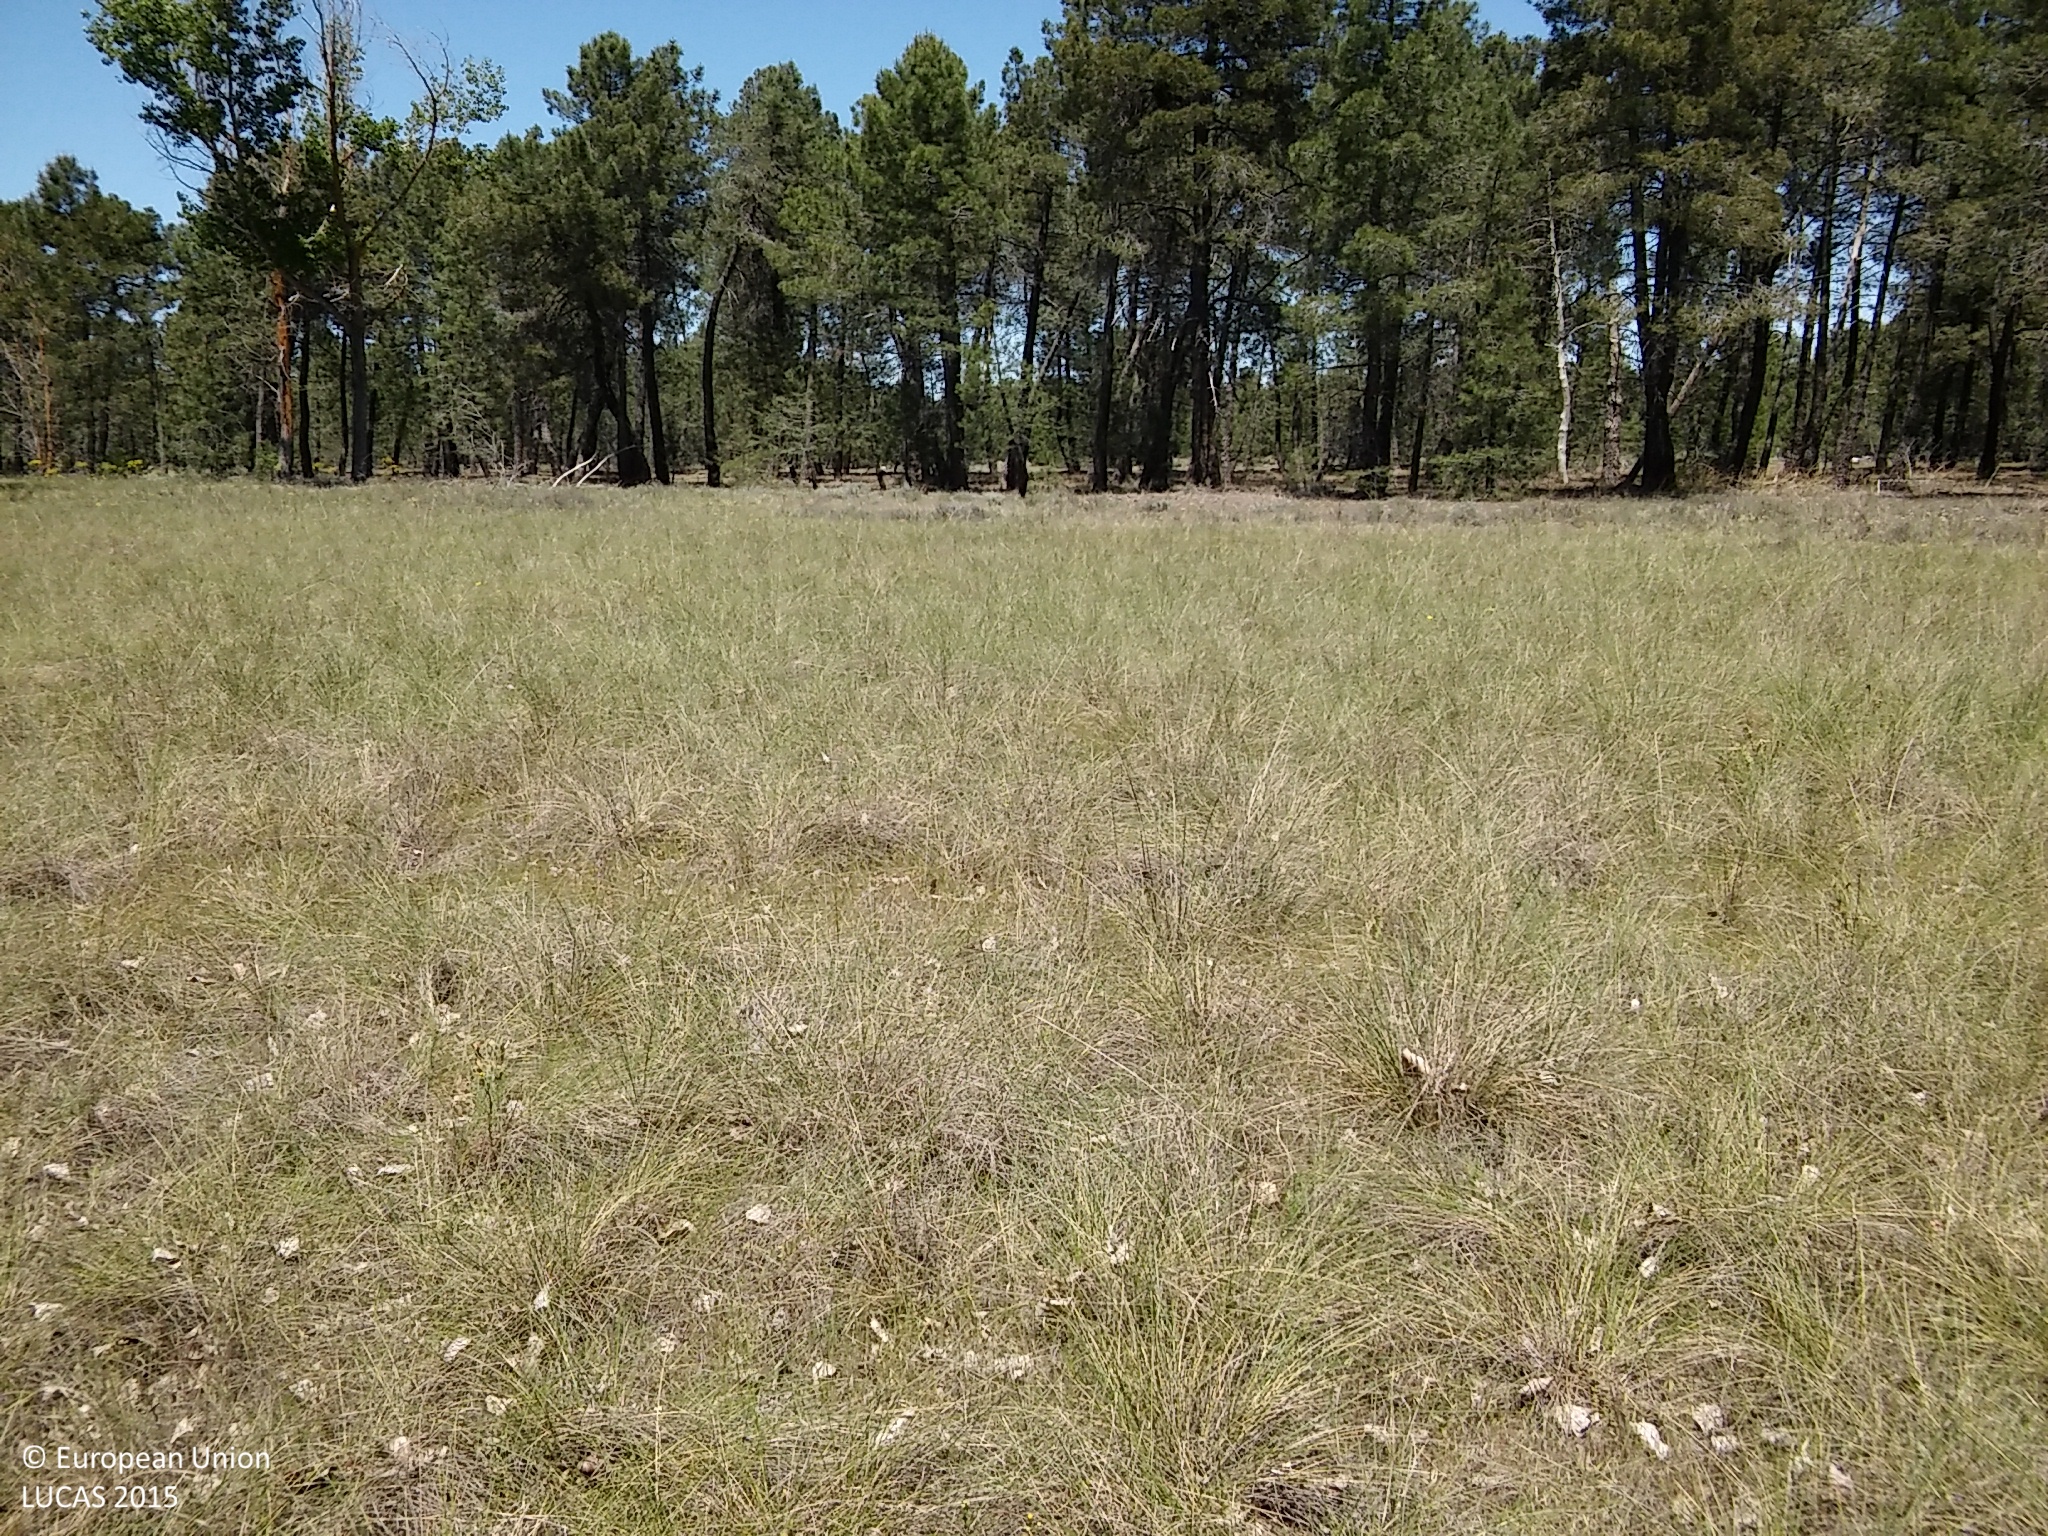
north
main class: Grassland
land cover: Grassland without tree/shrub cover
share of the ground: > 75 %
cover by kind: herbaceous plants 95 %, shrubs 5 %
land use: Semi-natural and natural areas not in use
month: May
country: ES
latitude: 41.2269
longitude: -4.0702
